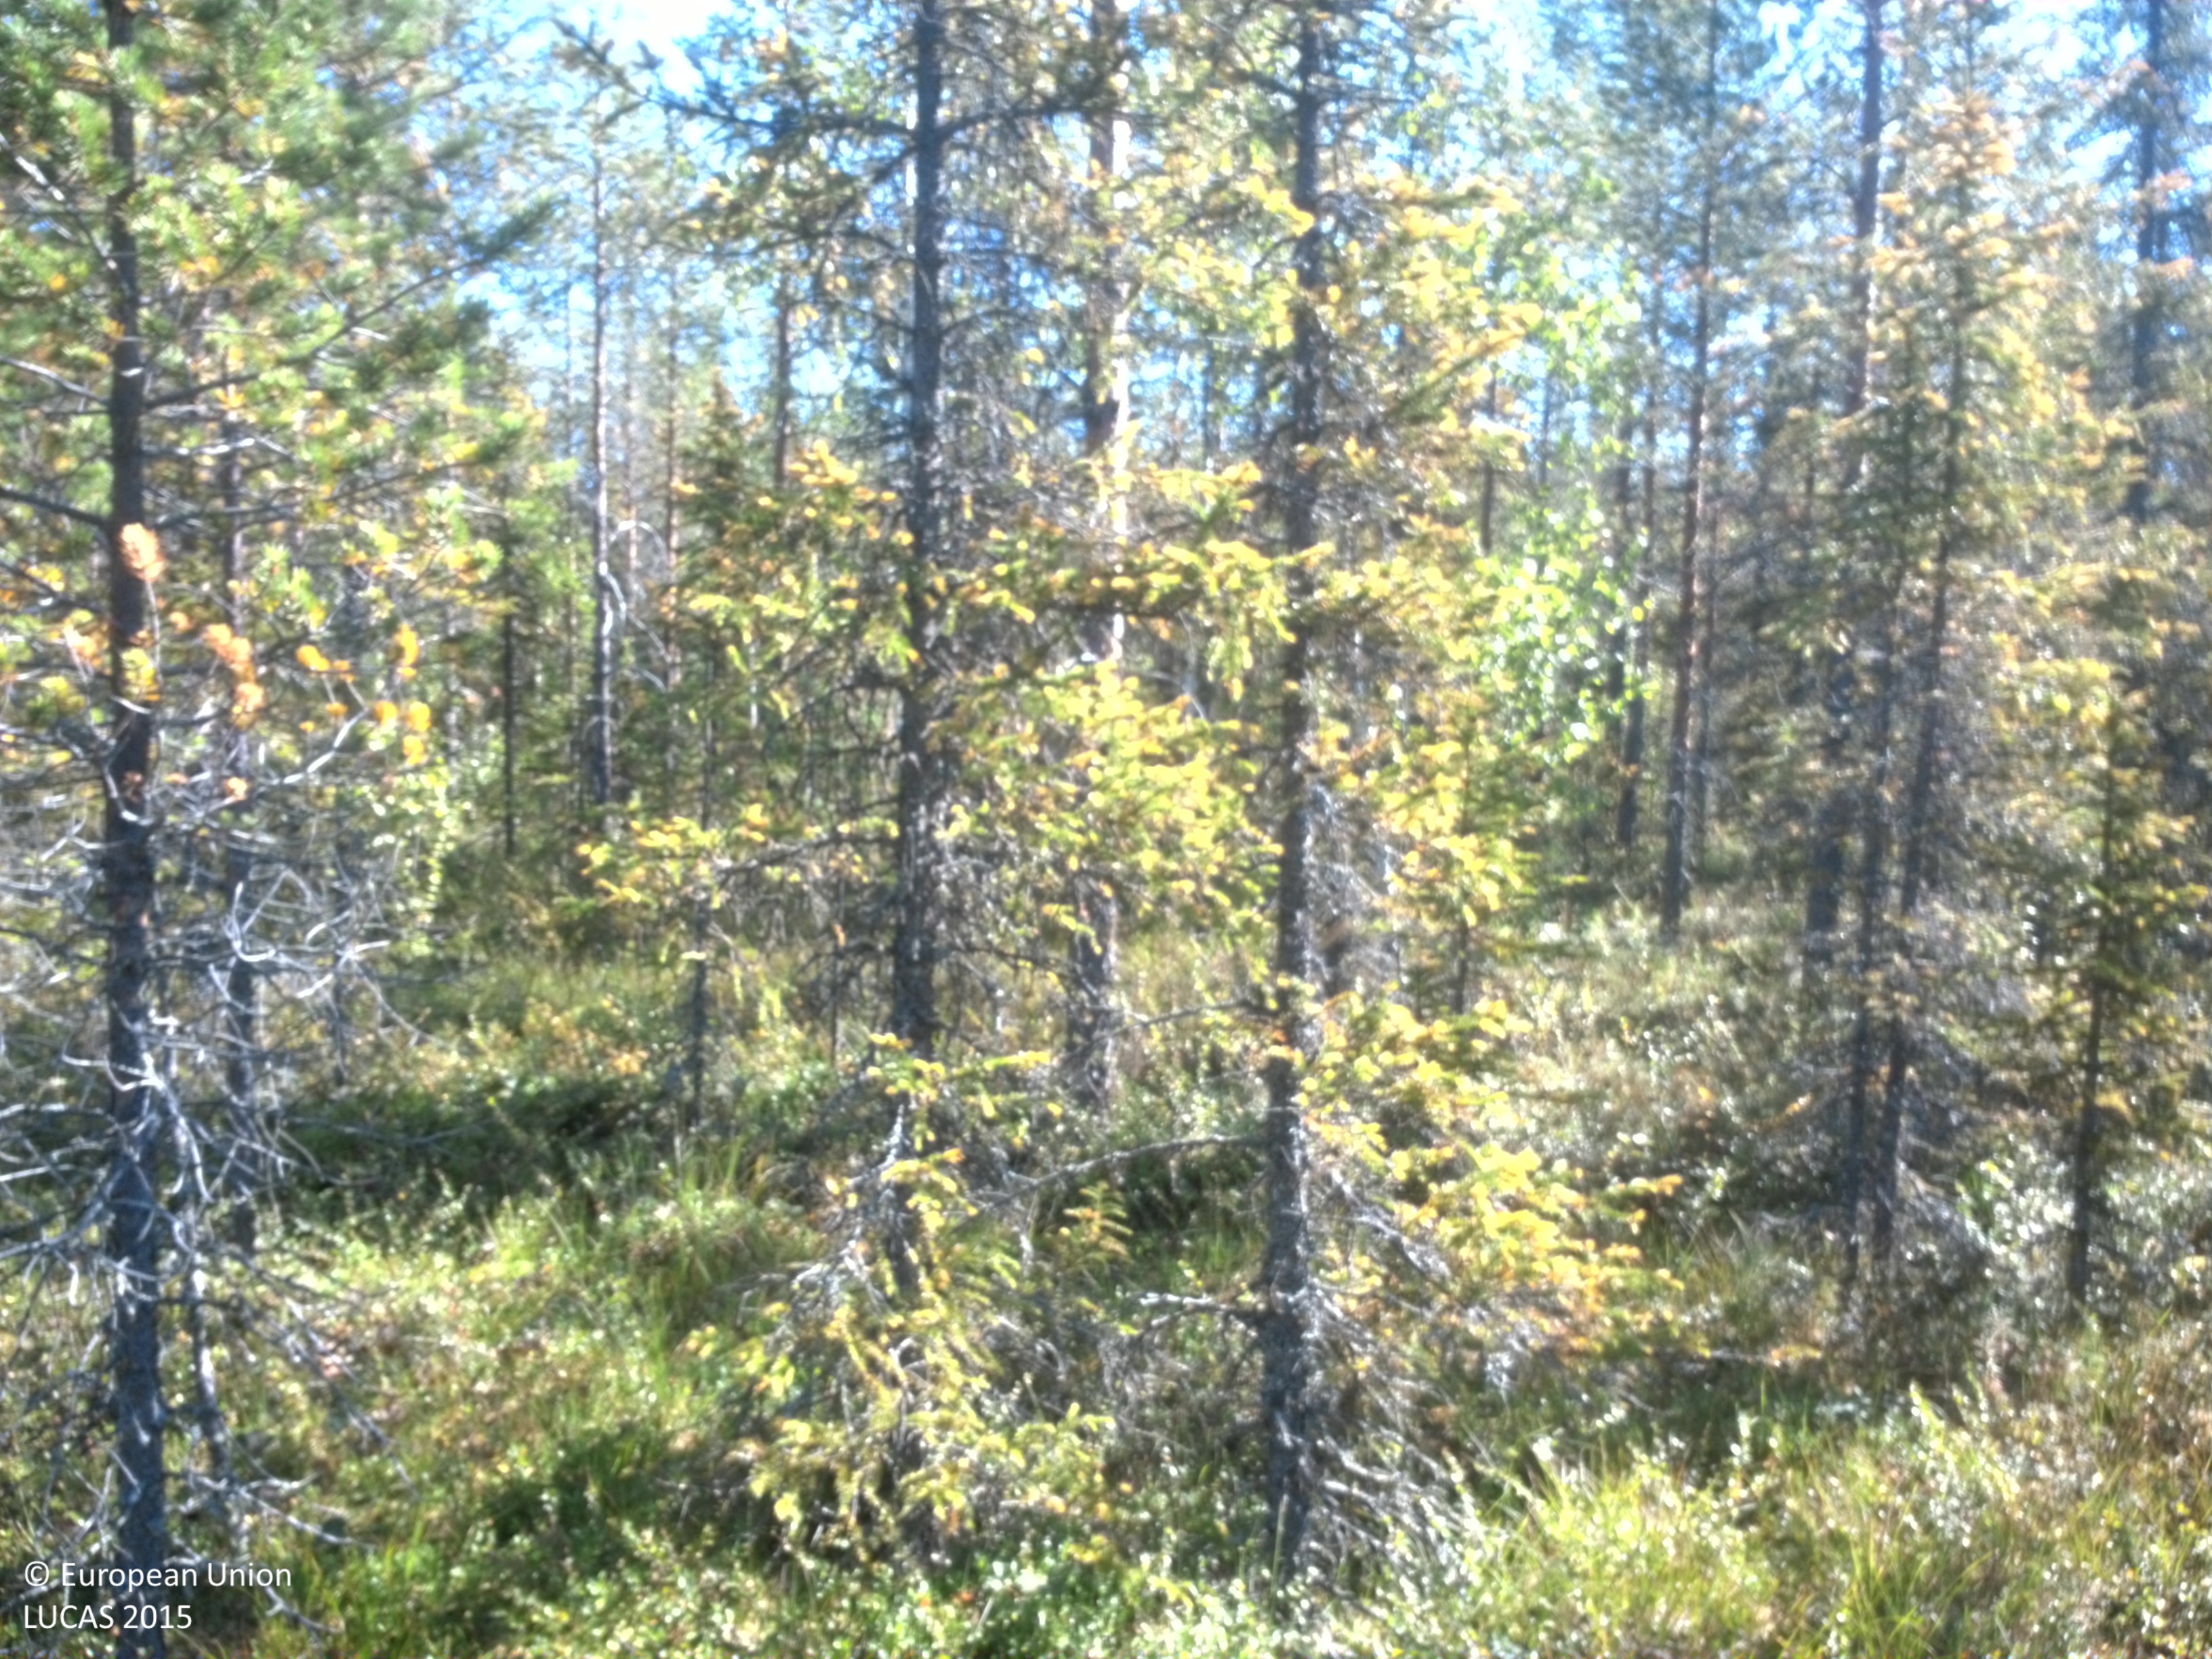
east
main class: Woodland
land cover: Pine dominated coniferous woodland
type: boreal forest
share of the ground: 50 - 75 %
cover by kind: coniferous forest trees 60 %, shrubs 20 %, herbaceous plants 10 %, lichens and mosses 10 %
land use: Forestry
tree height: > 5 m
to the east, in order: Pine dominated coniferous woodland; Pine dominated mixed woodland; Pine dominated coniferous woodland; Spruce dominated coniferous woodland
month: August
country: SE
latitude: 64.6950
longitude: 18.8791
